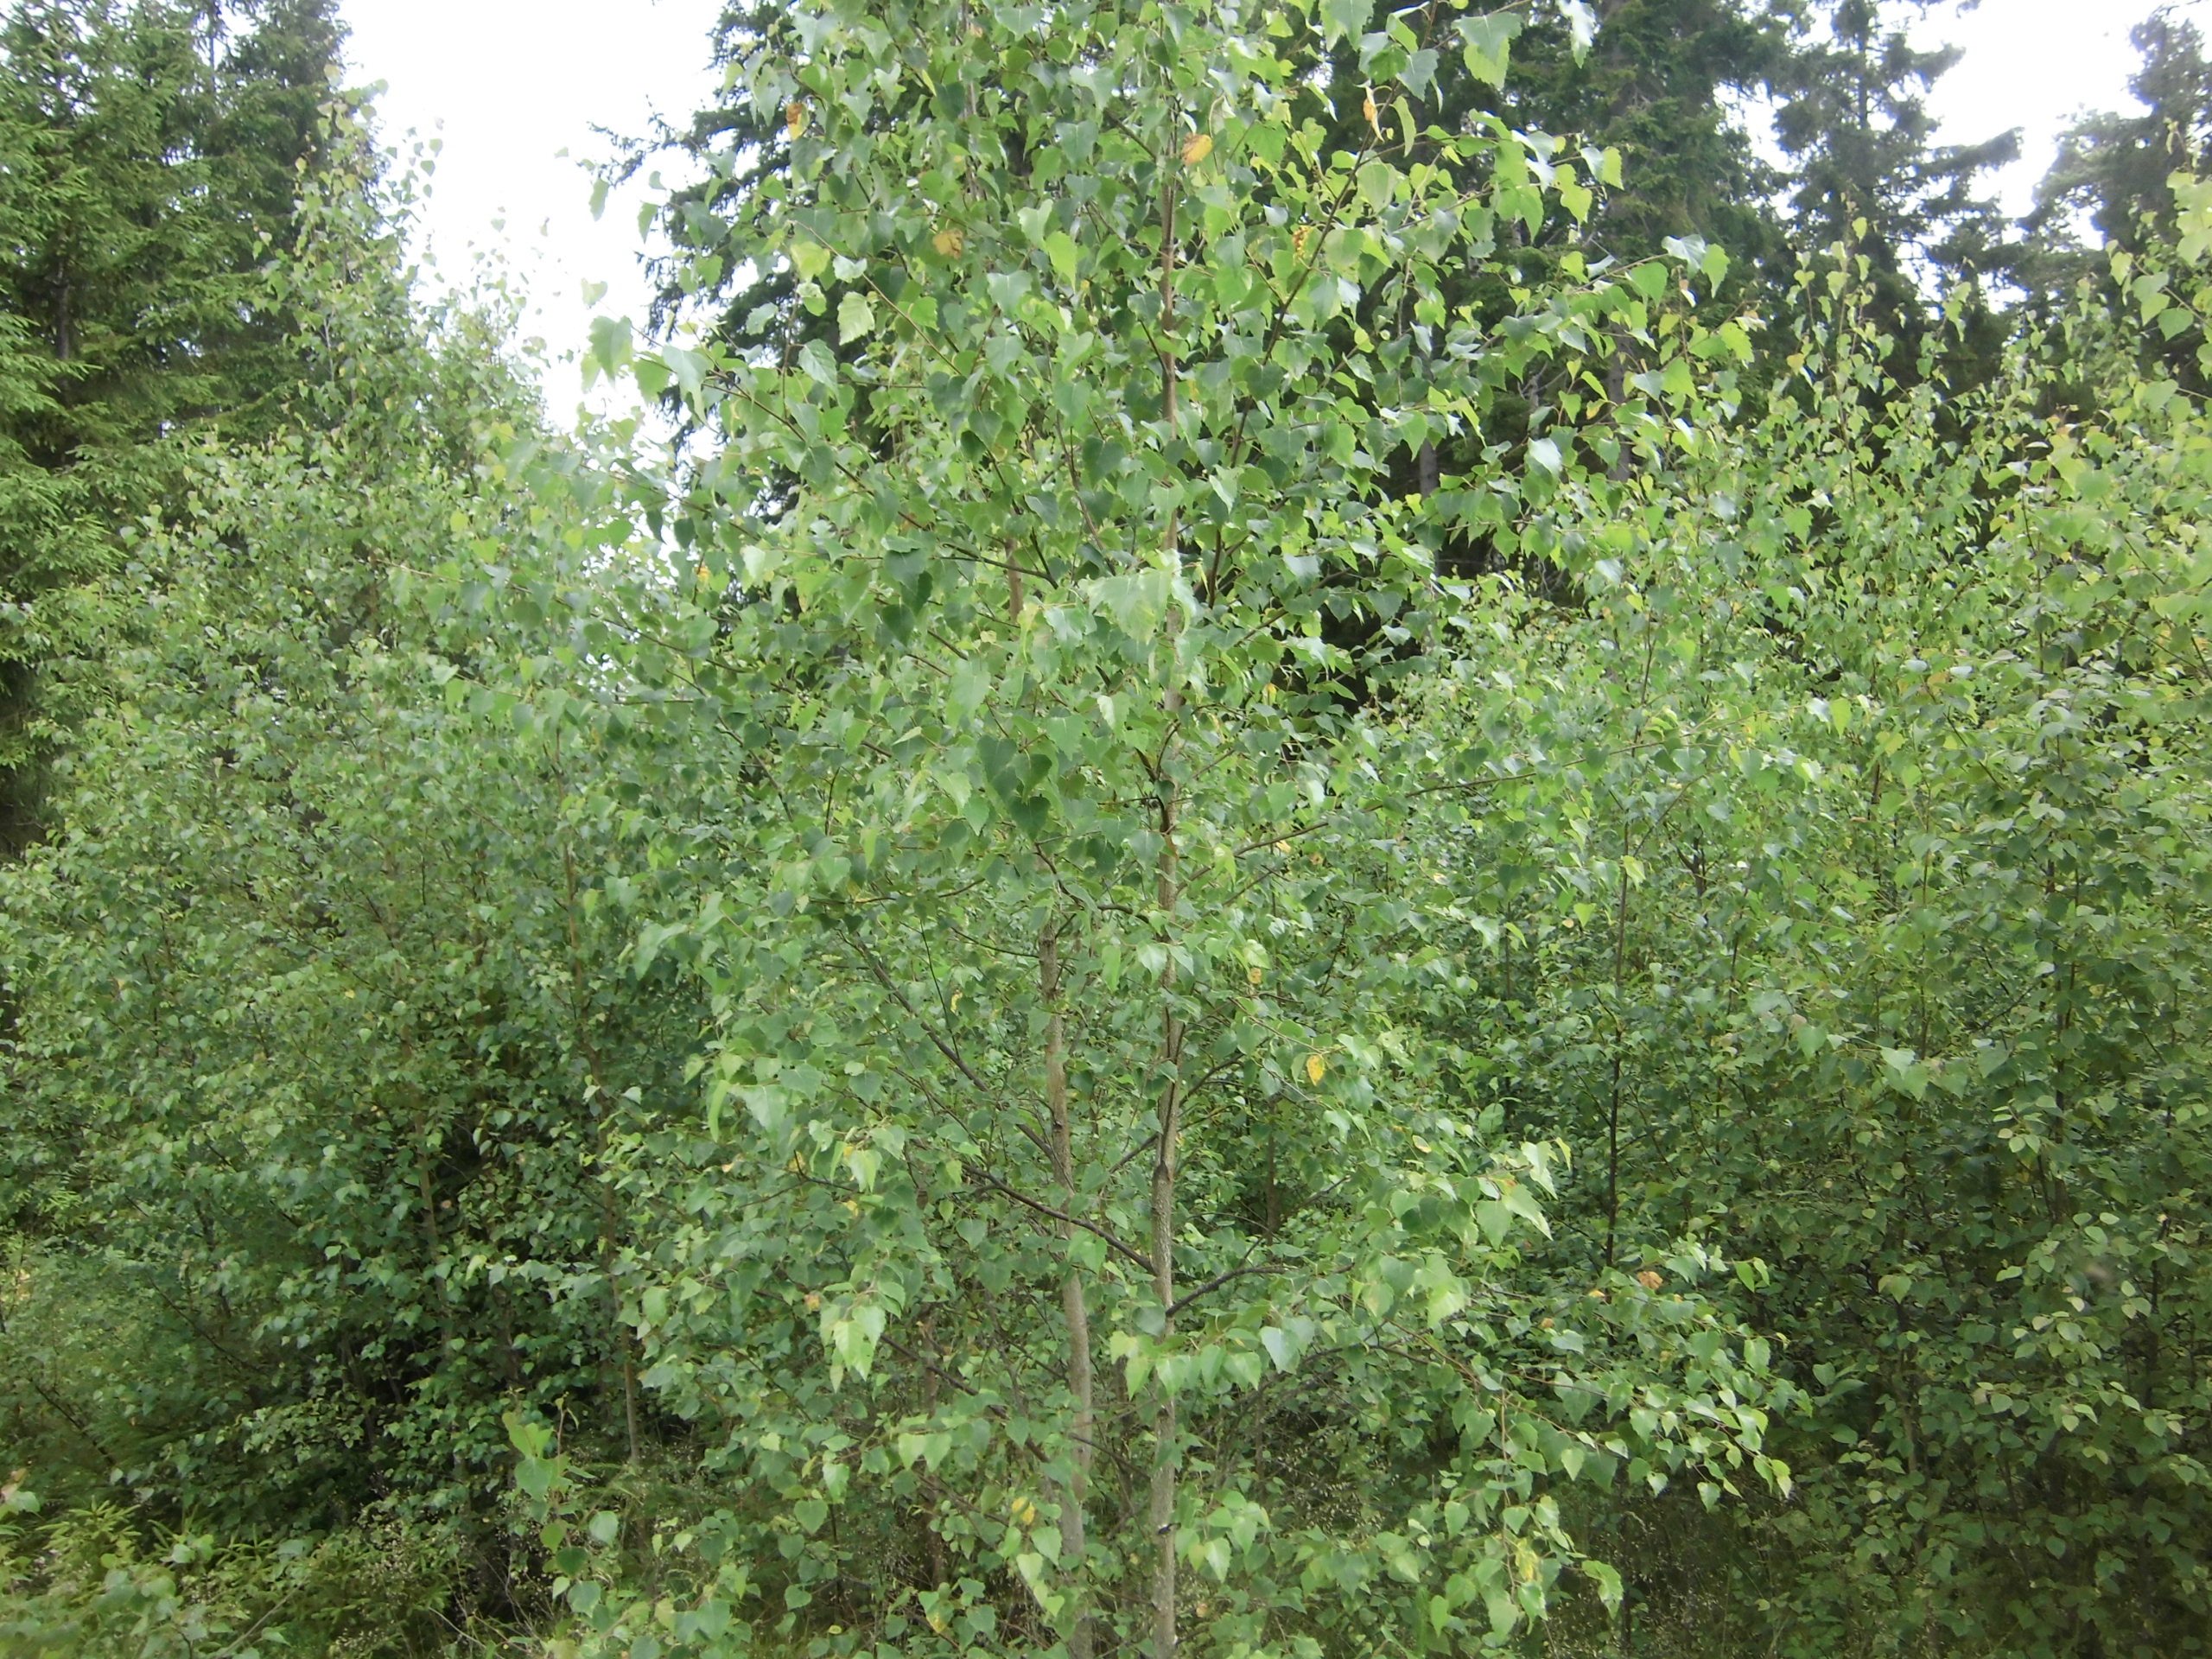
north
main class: Woodland
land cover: Pine dominated mixed woodland
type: boreal forest
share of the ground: 50 - 75 %
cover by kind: broadleaved forest trees 35 %, coniferous forest trees 25 %, herbaceous plants 20 %, shrubs 10 %, lichens and mosses 10 %
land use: Forestry
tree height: > 5 m
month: July
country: SE
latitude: 57.4450
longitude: 14.9114
